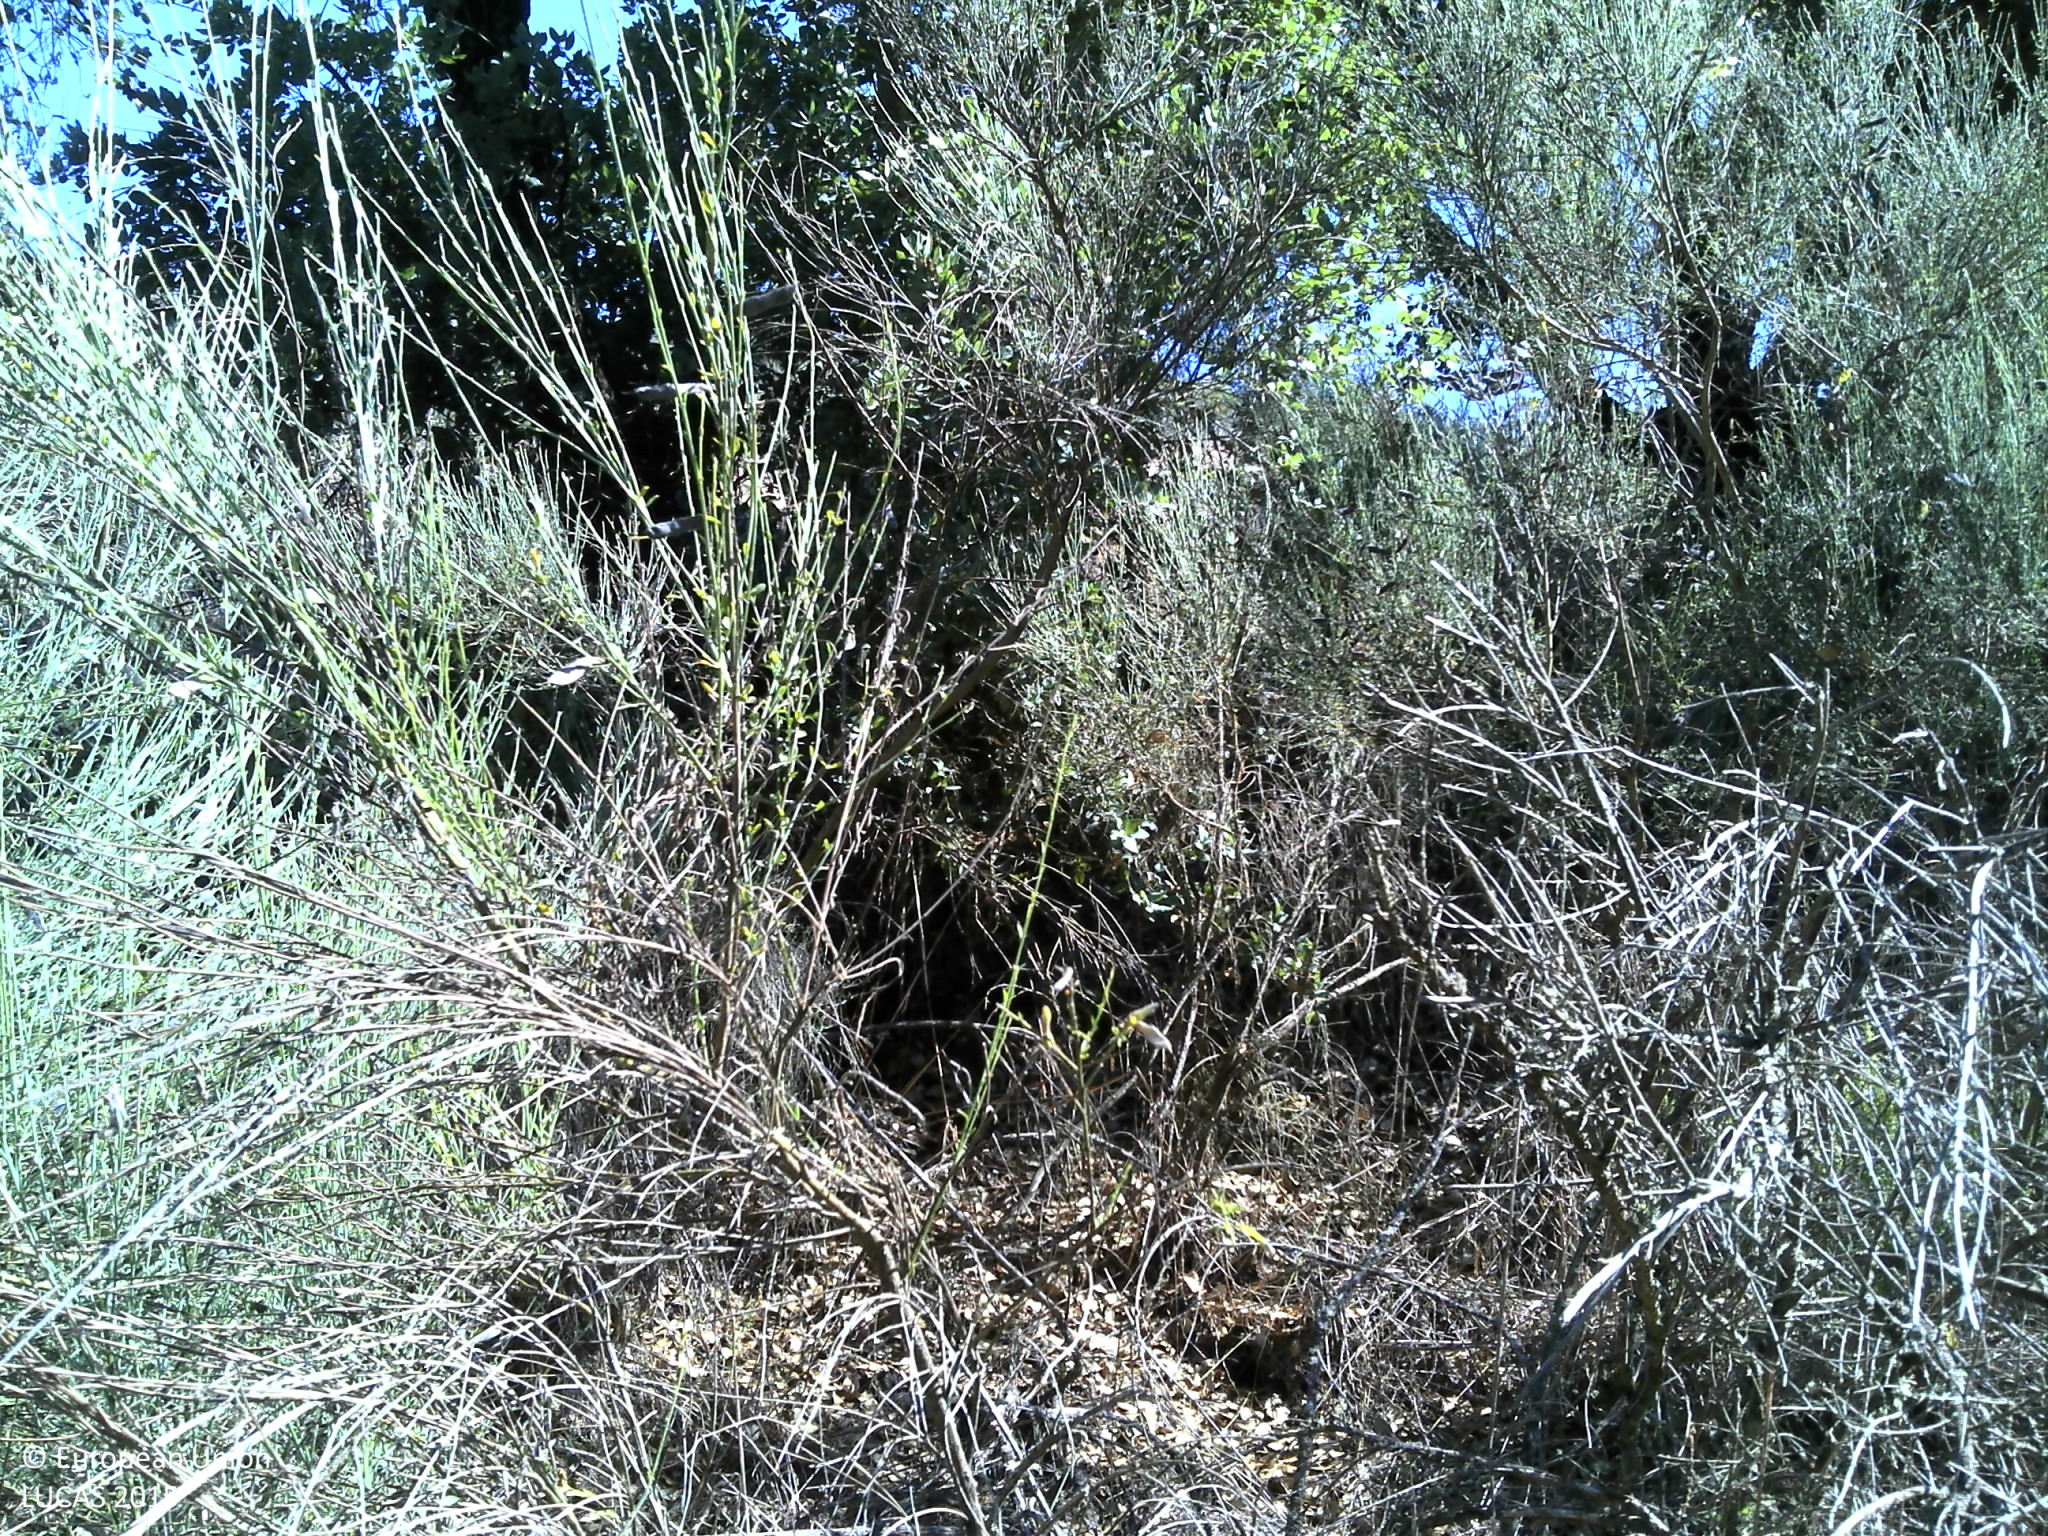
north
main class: Shrubland
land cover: Shrubland with sparse tree cover
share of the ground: > 75 %
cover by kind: shrubs 95 %, broadleaved forest trees 5 %
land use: Semi-natural and natural areas not in use
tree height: > 5 m
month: June
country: PT
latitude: 41.4461
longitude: -6.8802
